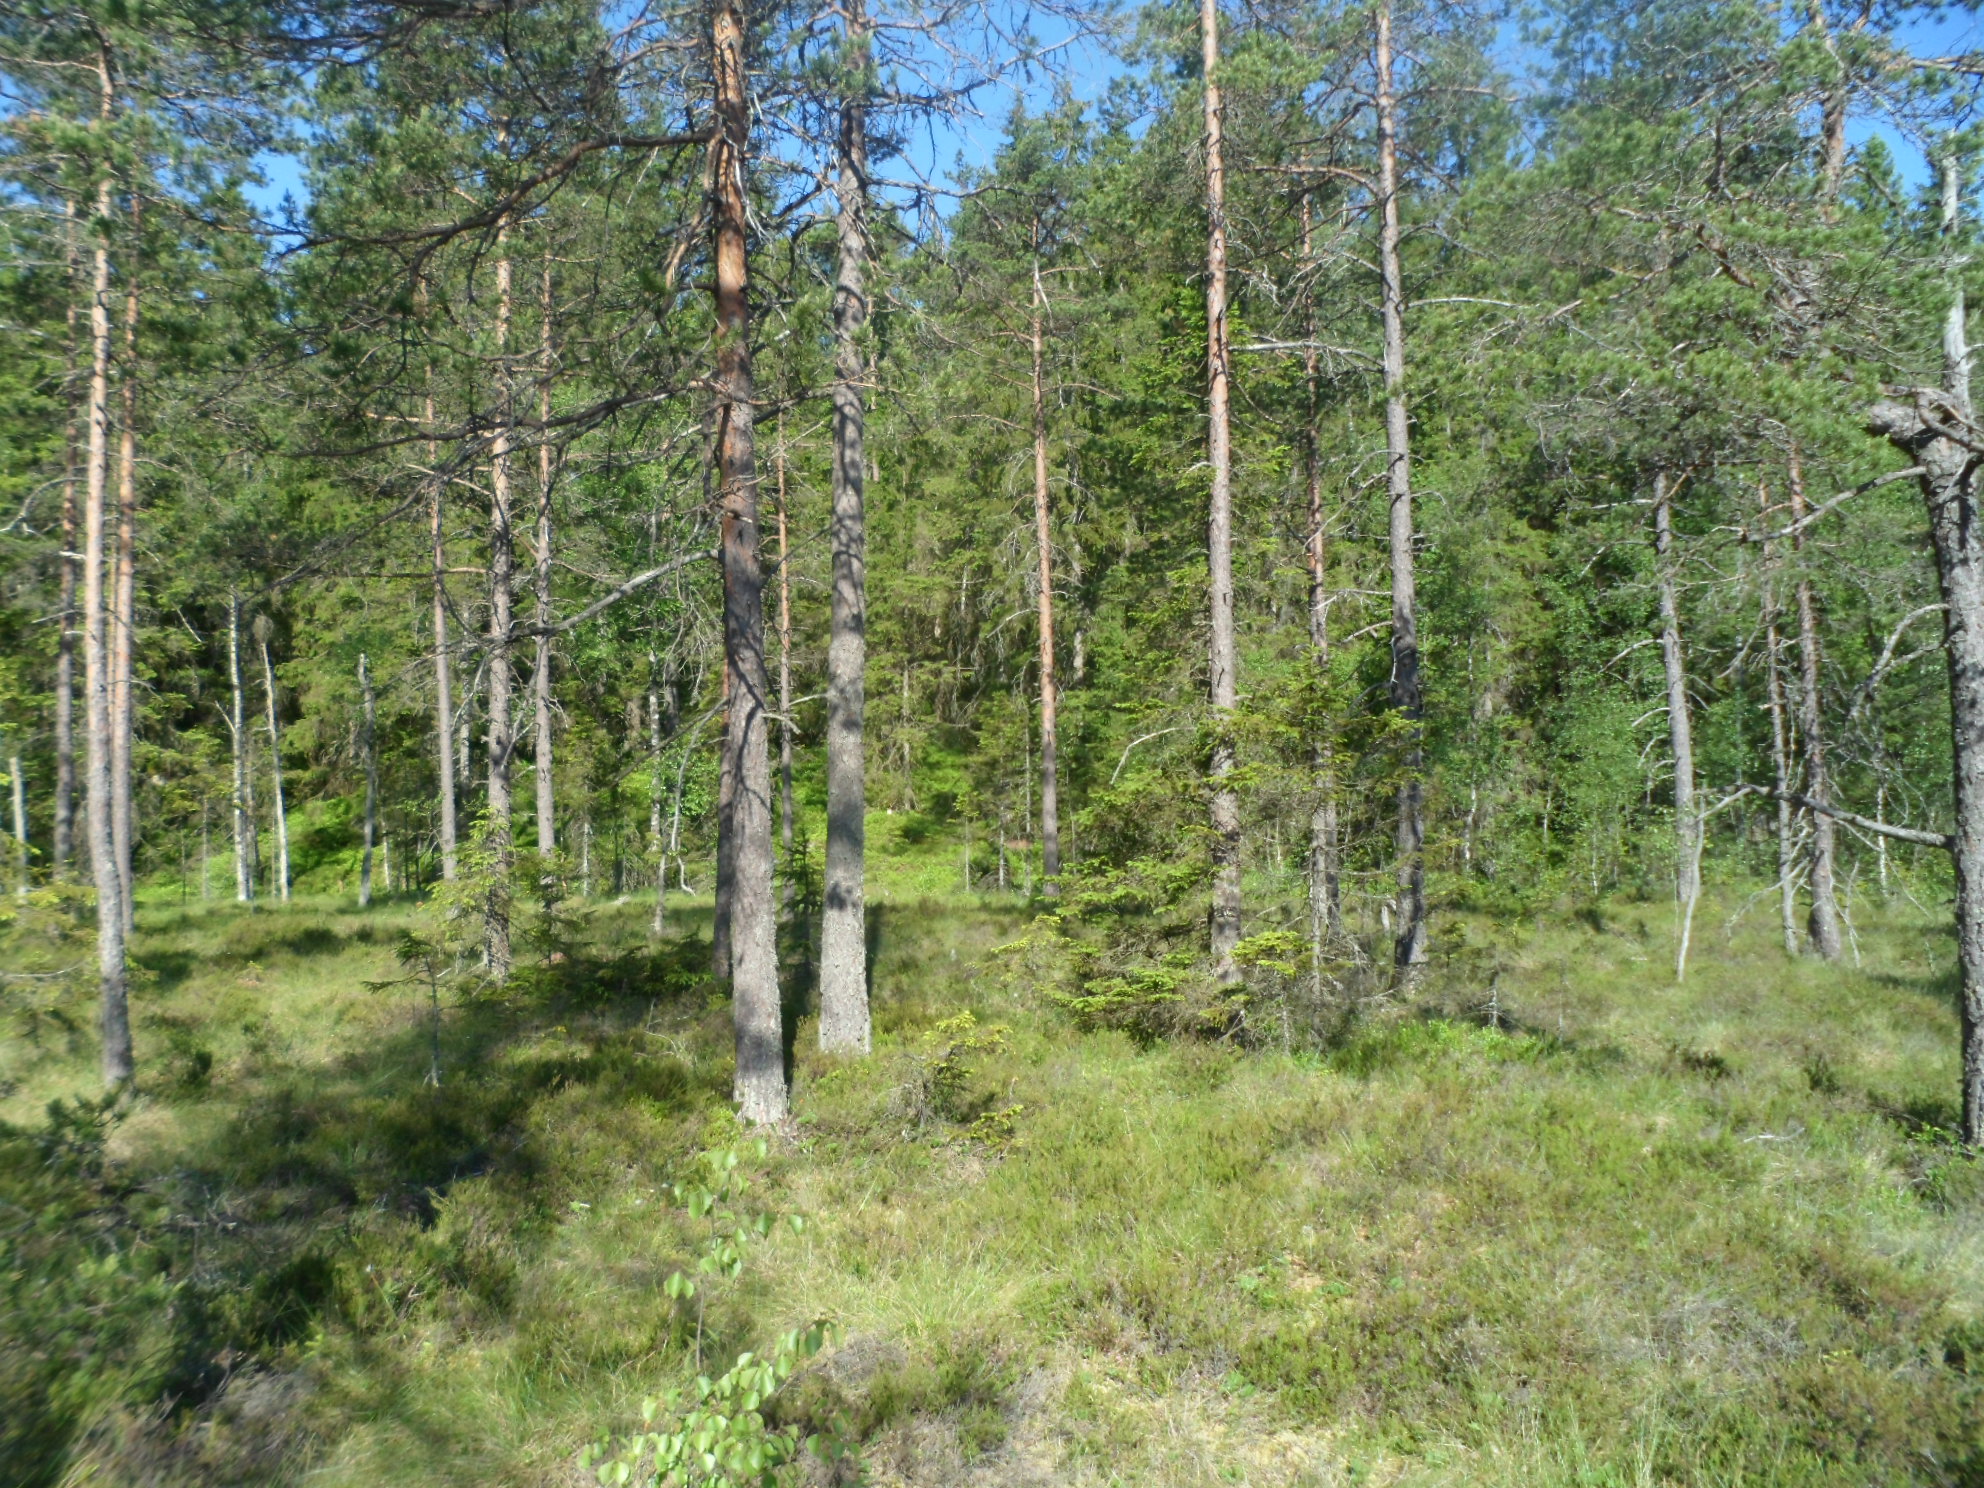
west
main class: Woodland
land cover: Pine dominated coniferous woodland
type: boreal forest
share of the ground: 25 - 50 %
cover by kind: shrubs 35 %, coniferous forest trees 25 %, lichens and mosses 25 %, herbaceous plants 10 %, broadleaved forest trees 5 %
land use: Forestry
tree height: > 5 m
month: July
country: SE
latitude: 57.4962
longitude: 14.4840
